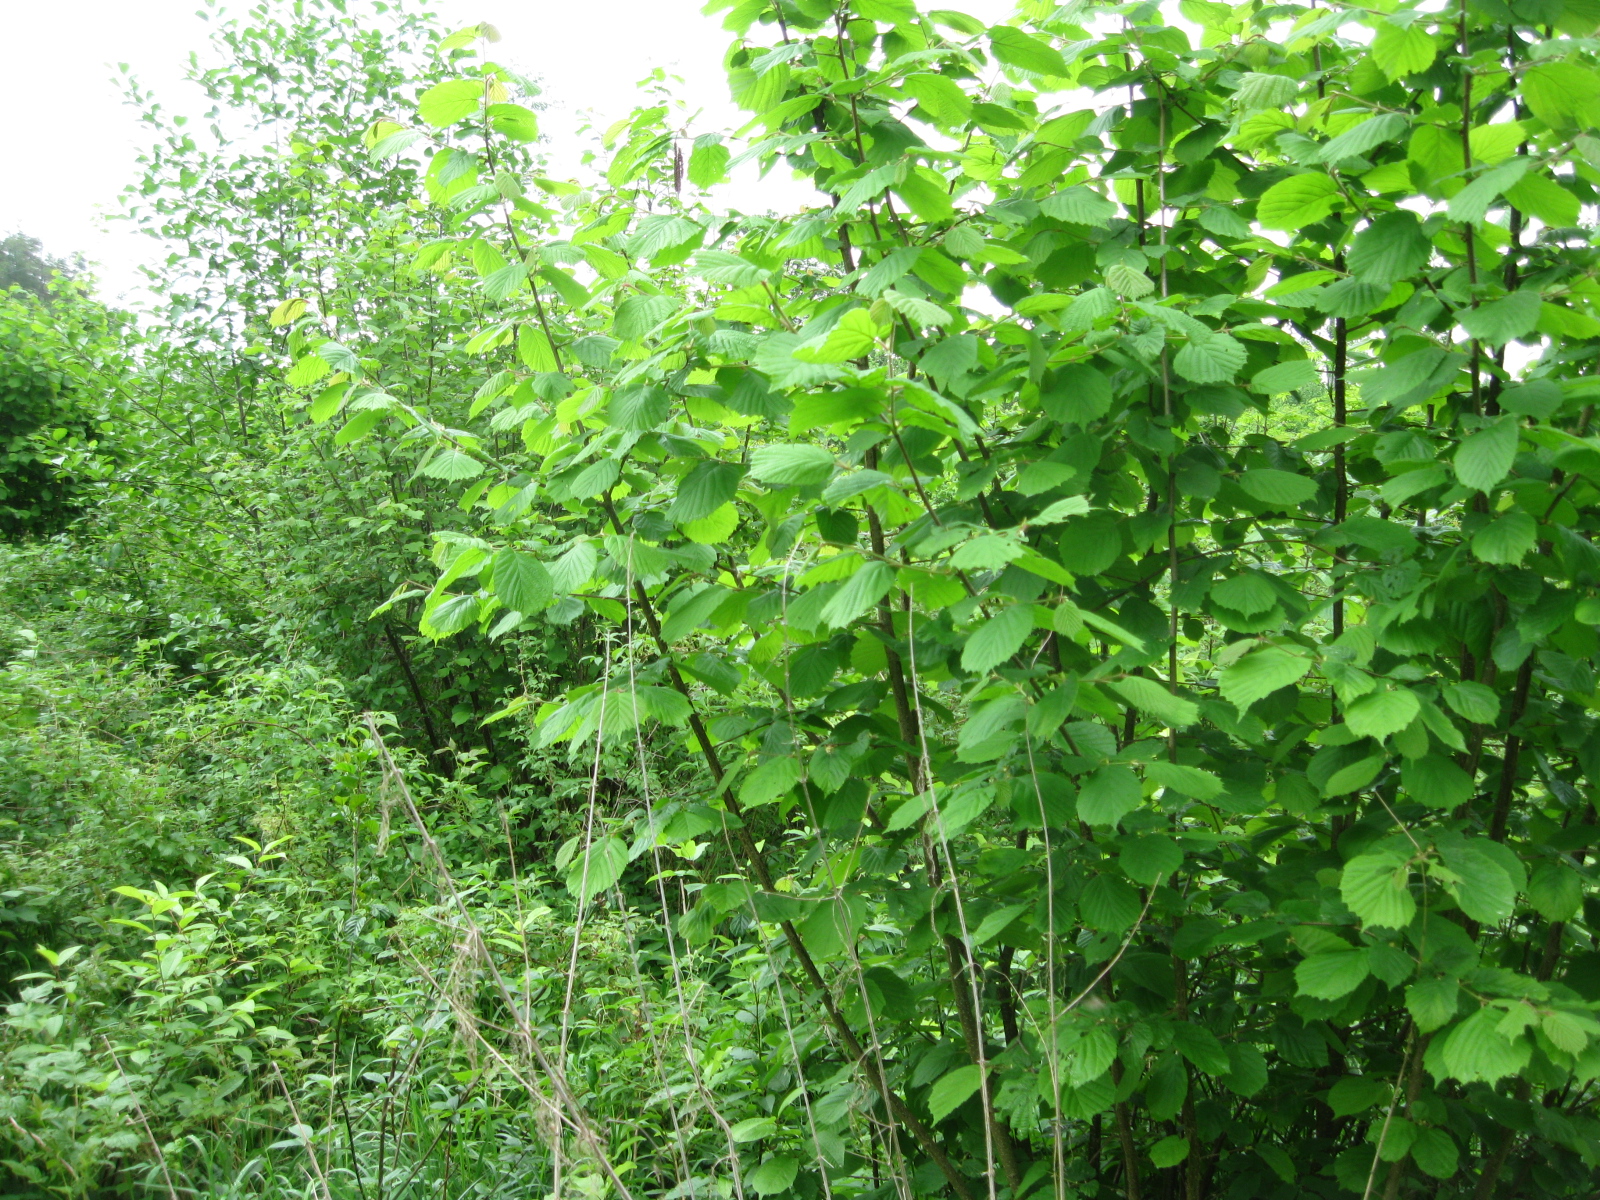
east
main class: Woodland
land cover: Broadleaved woodland
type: non-riverine alder, birch or aspen forest
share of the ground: > 75 %
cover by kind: broadleaved forest trees 80 %, shrubs 15 %, herbaceous plants 5 %
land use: Forestry
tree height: < 5 m
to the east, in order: Broadleaved woodland
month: June
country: LT
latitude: 55.8817
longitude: 24.0770
